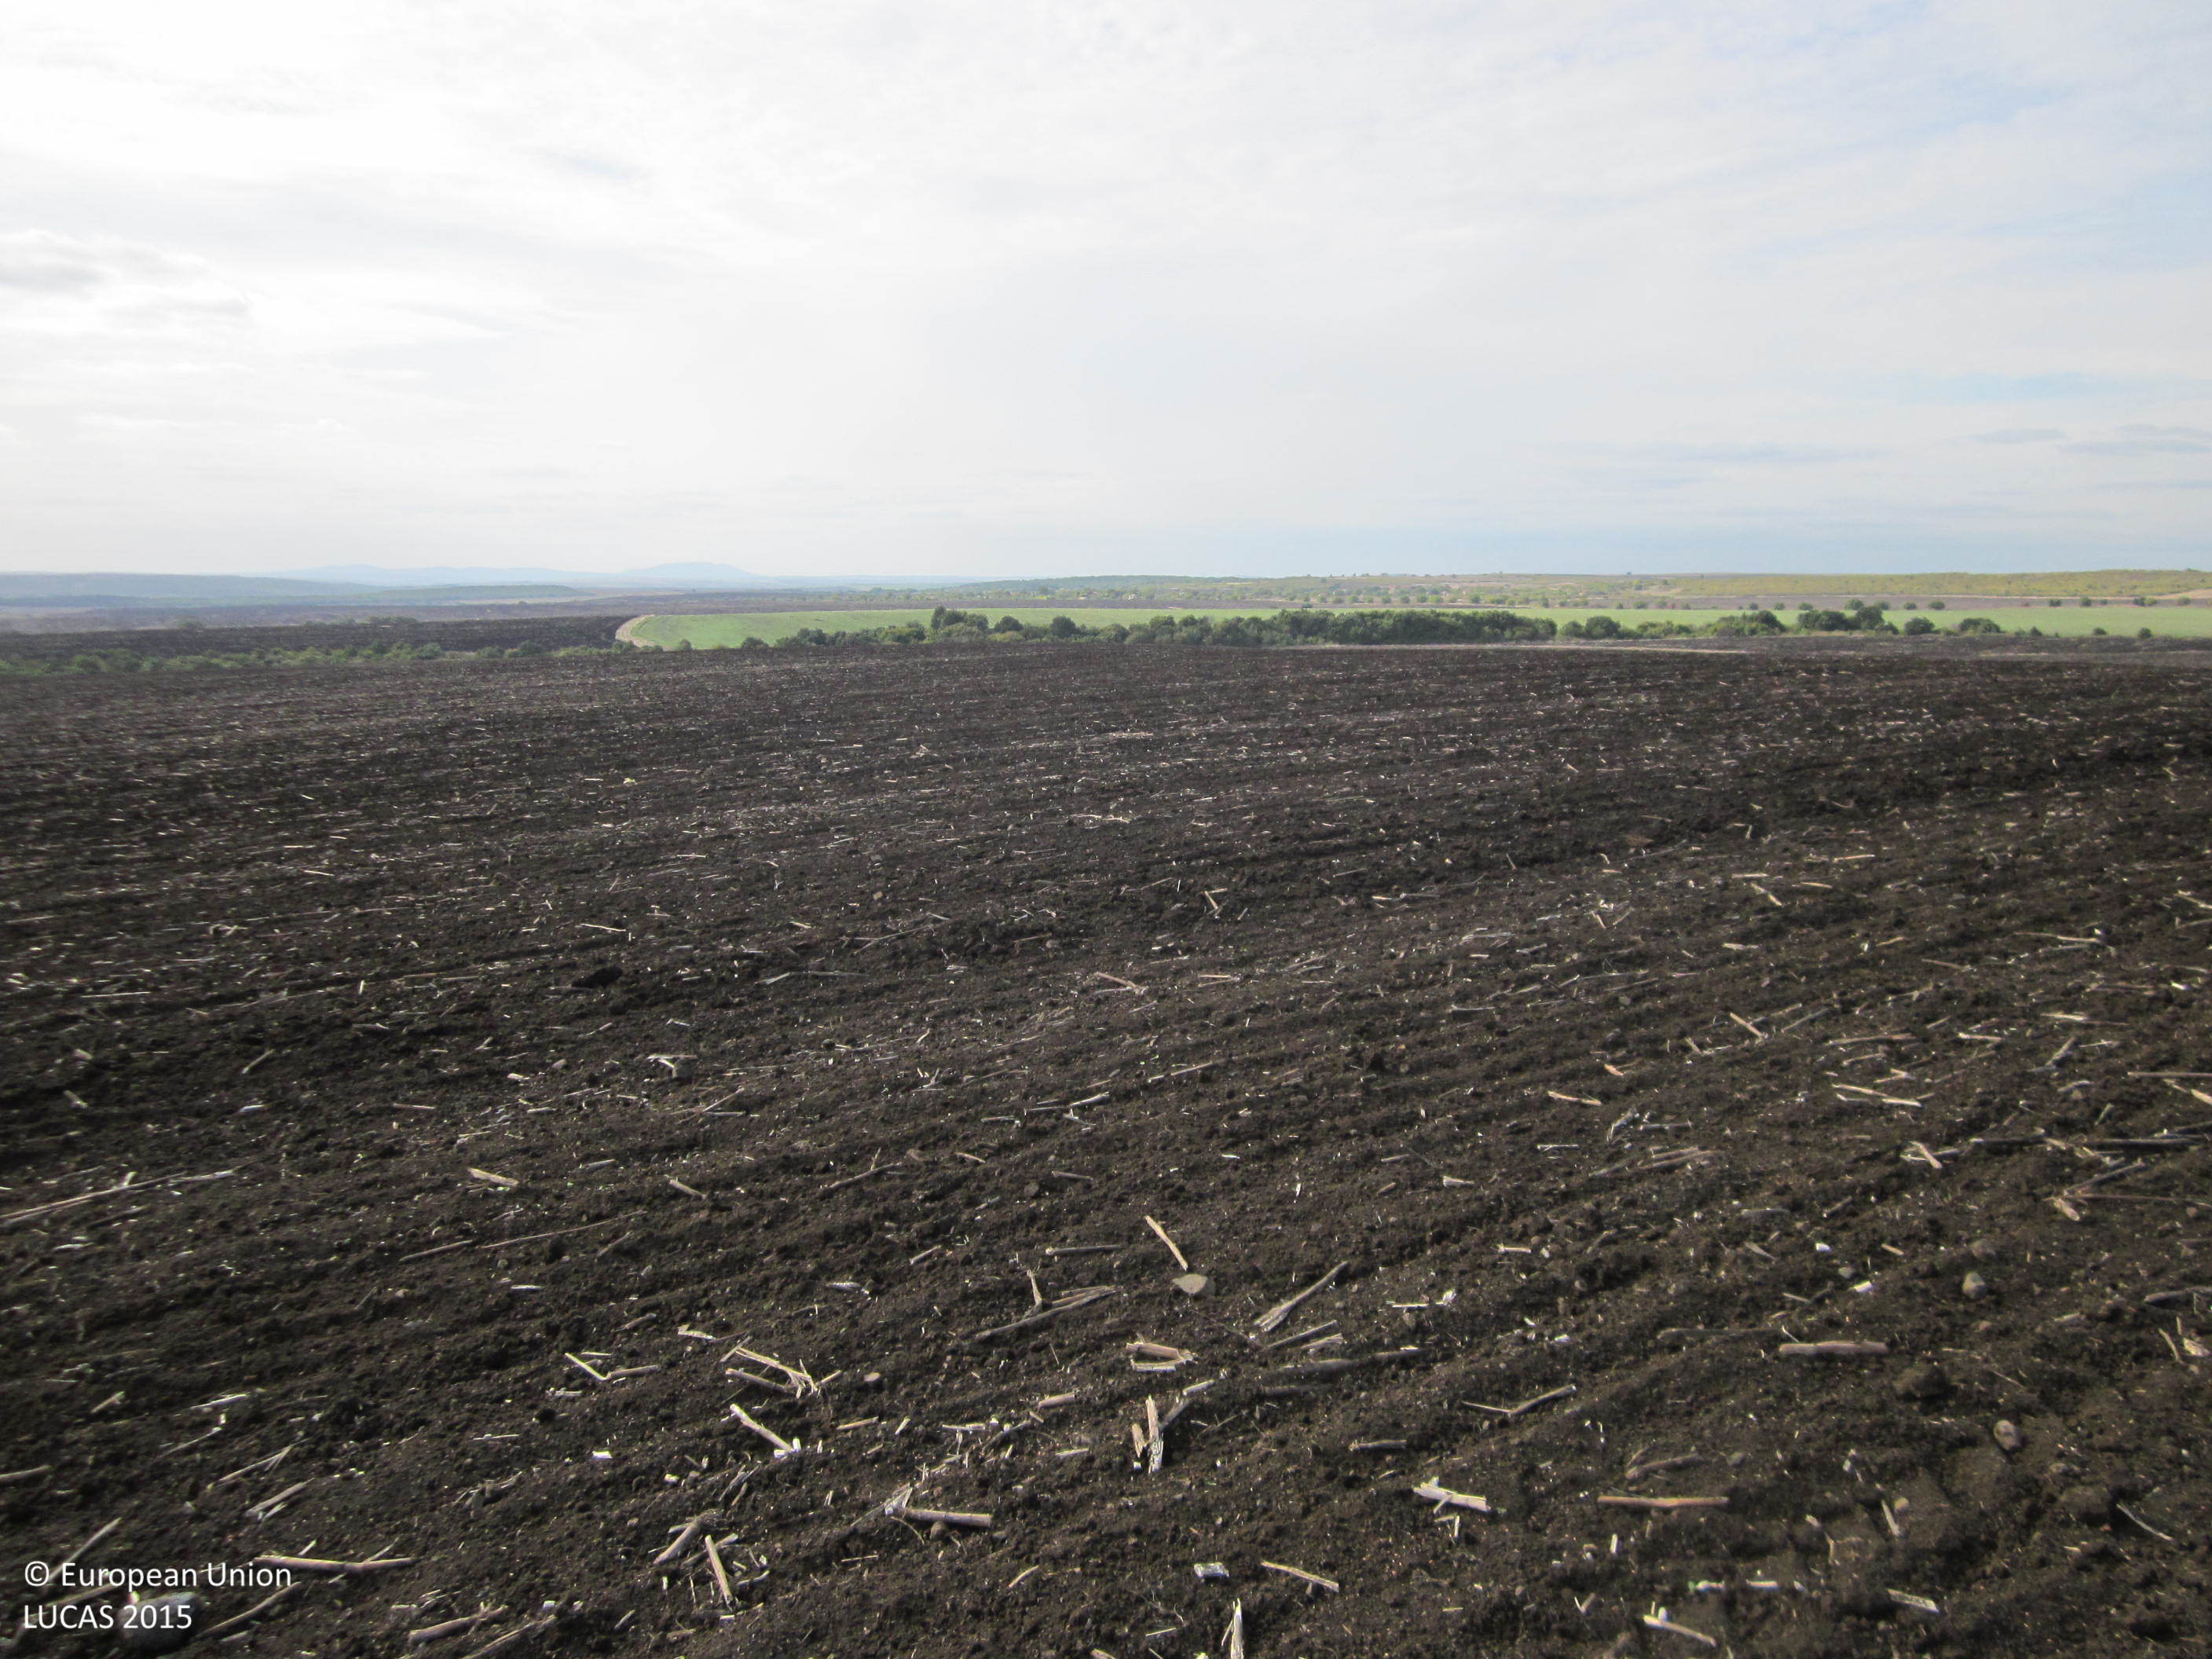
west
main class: Cropland
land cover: Sunflower
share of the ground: < 10 %
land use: Agriculture (excluding fallow land and kitchen gardens)
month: October
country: BG
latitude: 42.4278
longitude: 27.0608
